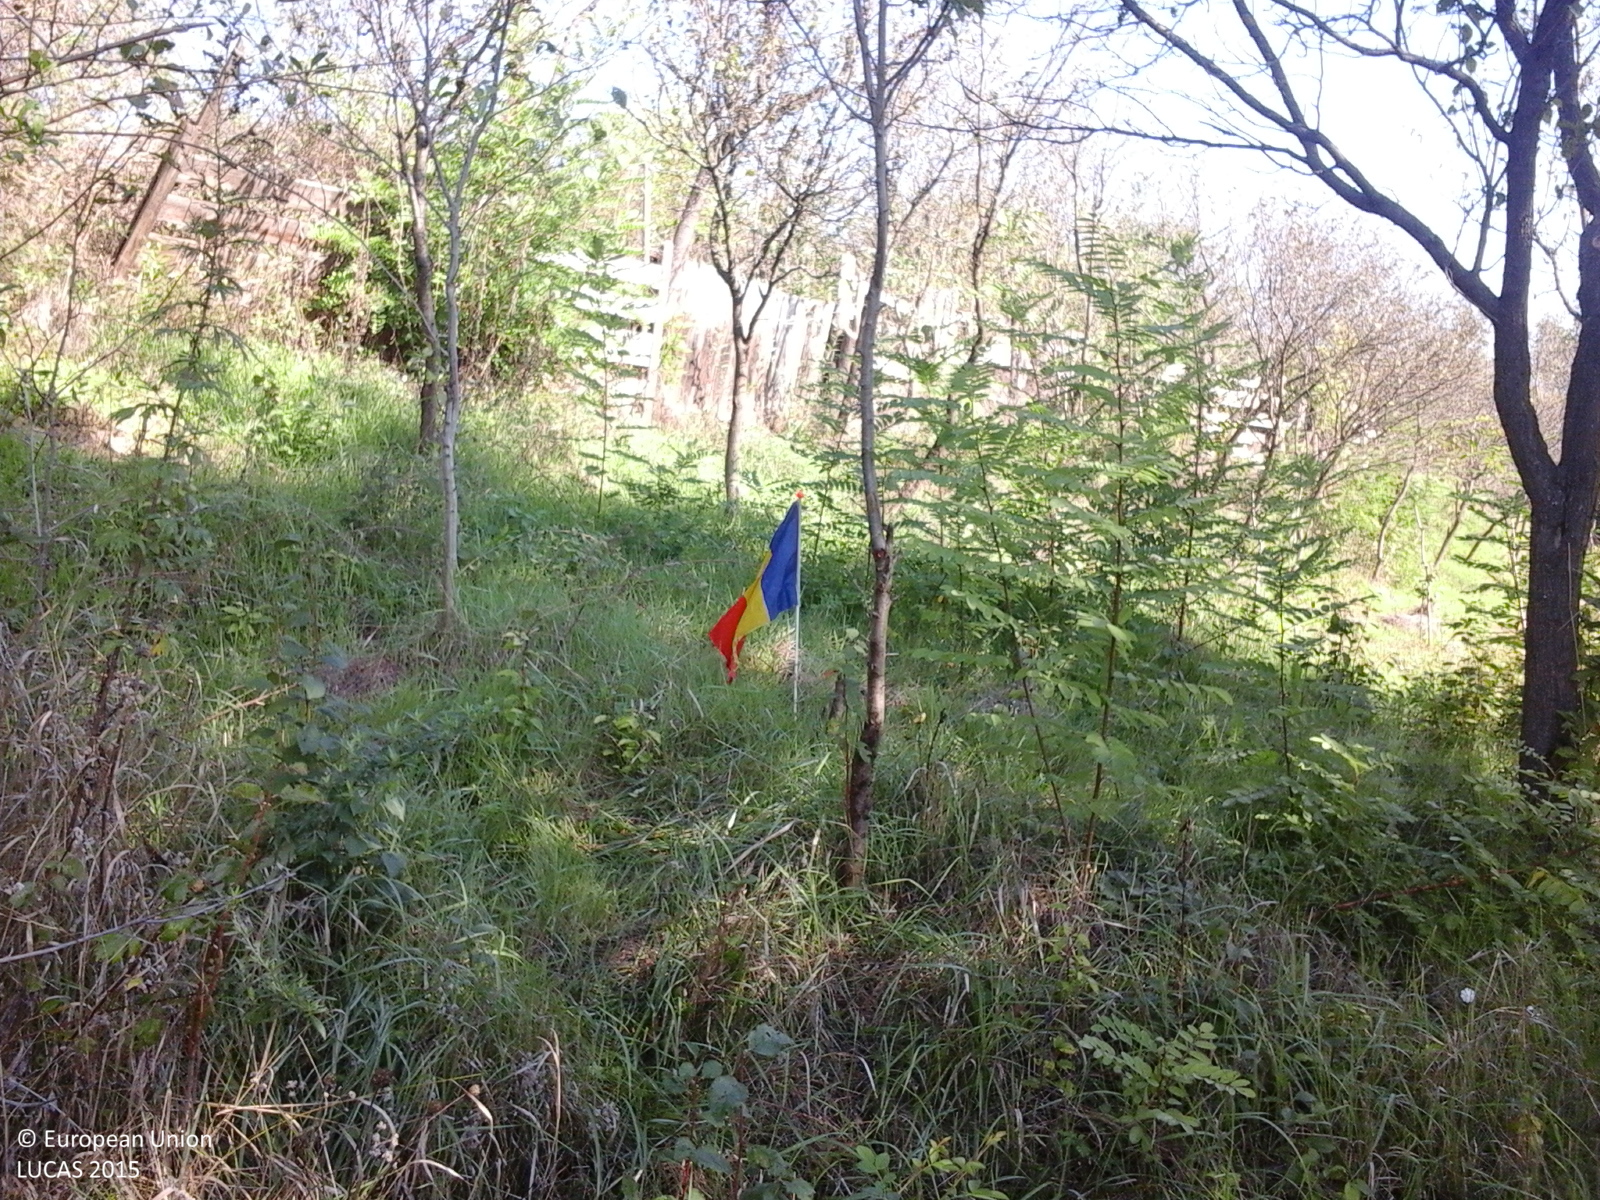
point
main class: Cropland
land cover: Other fruit trees and berries
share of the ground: 25 - 50 %
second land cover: Grassland without tree/shrub cover
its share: > 75 %
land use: Agriculture (excluding fallow land and kitchen gardens)
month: October
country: RO
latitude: 46.0740
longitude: 23.7885
